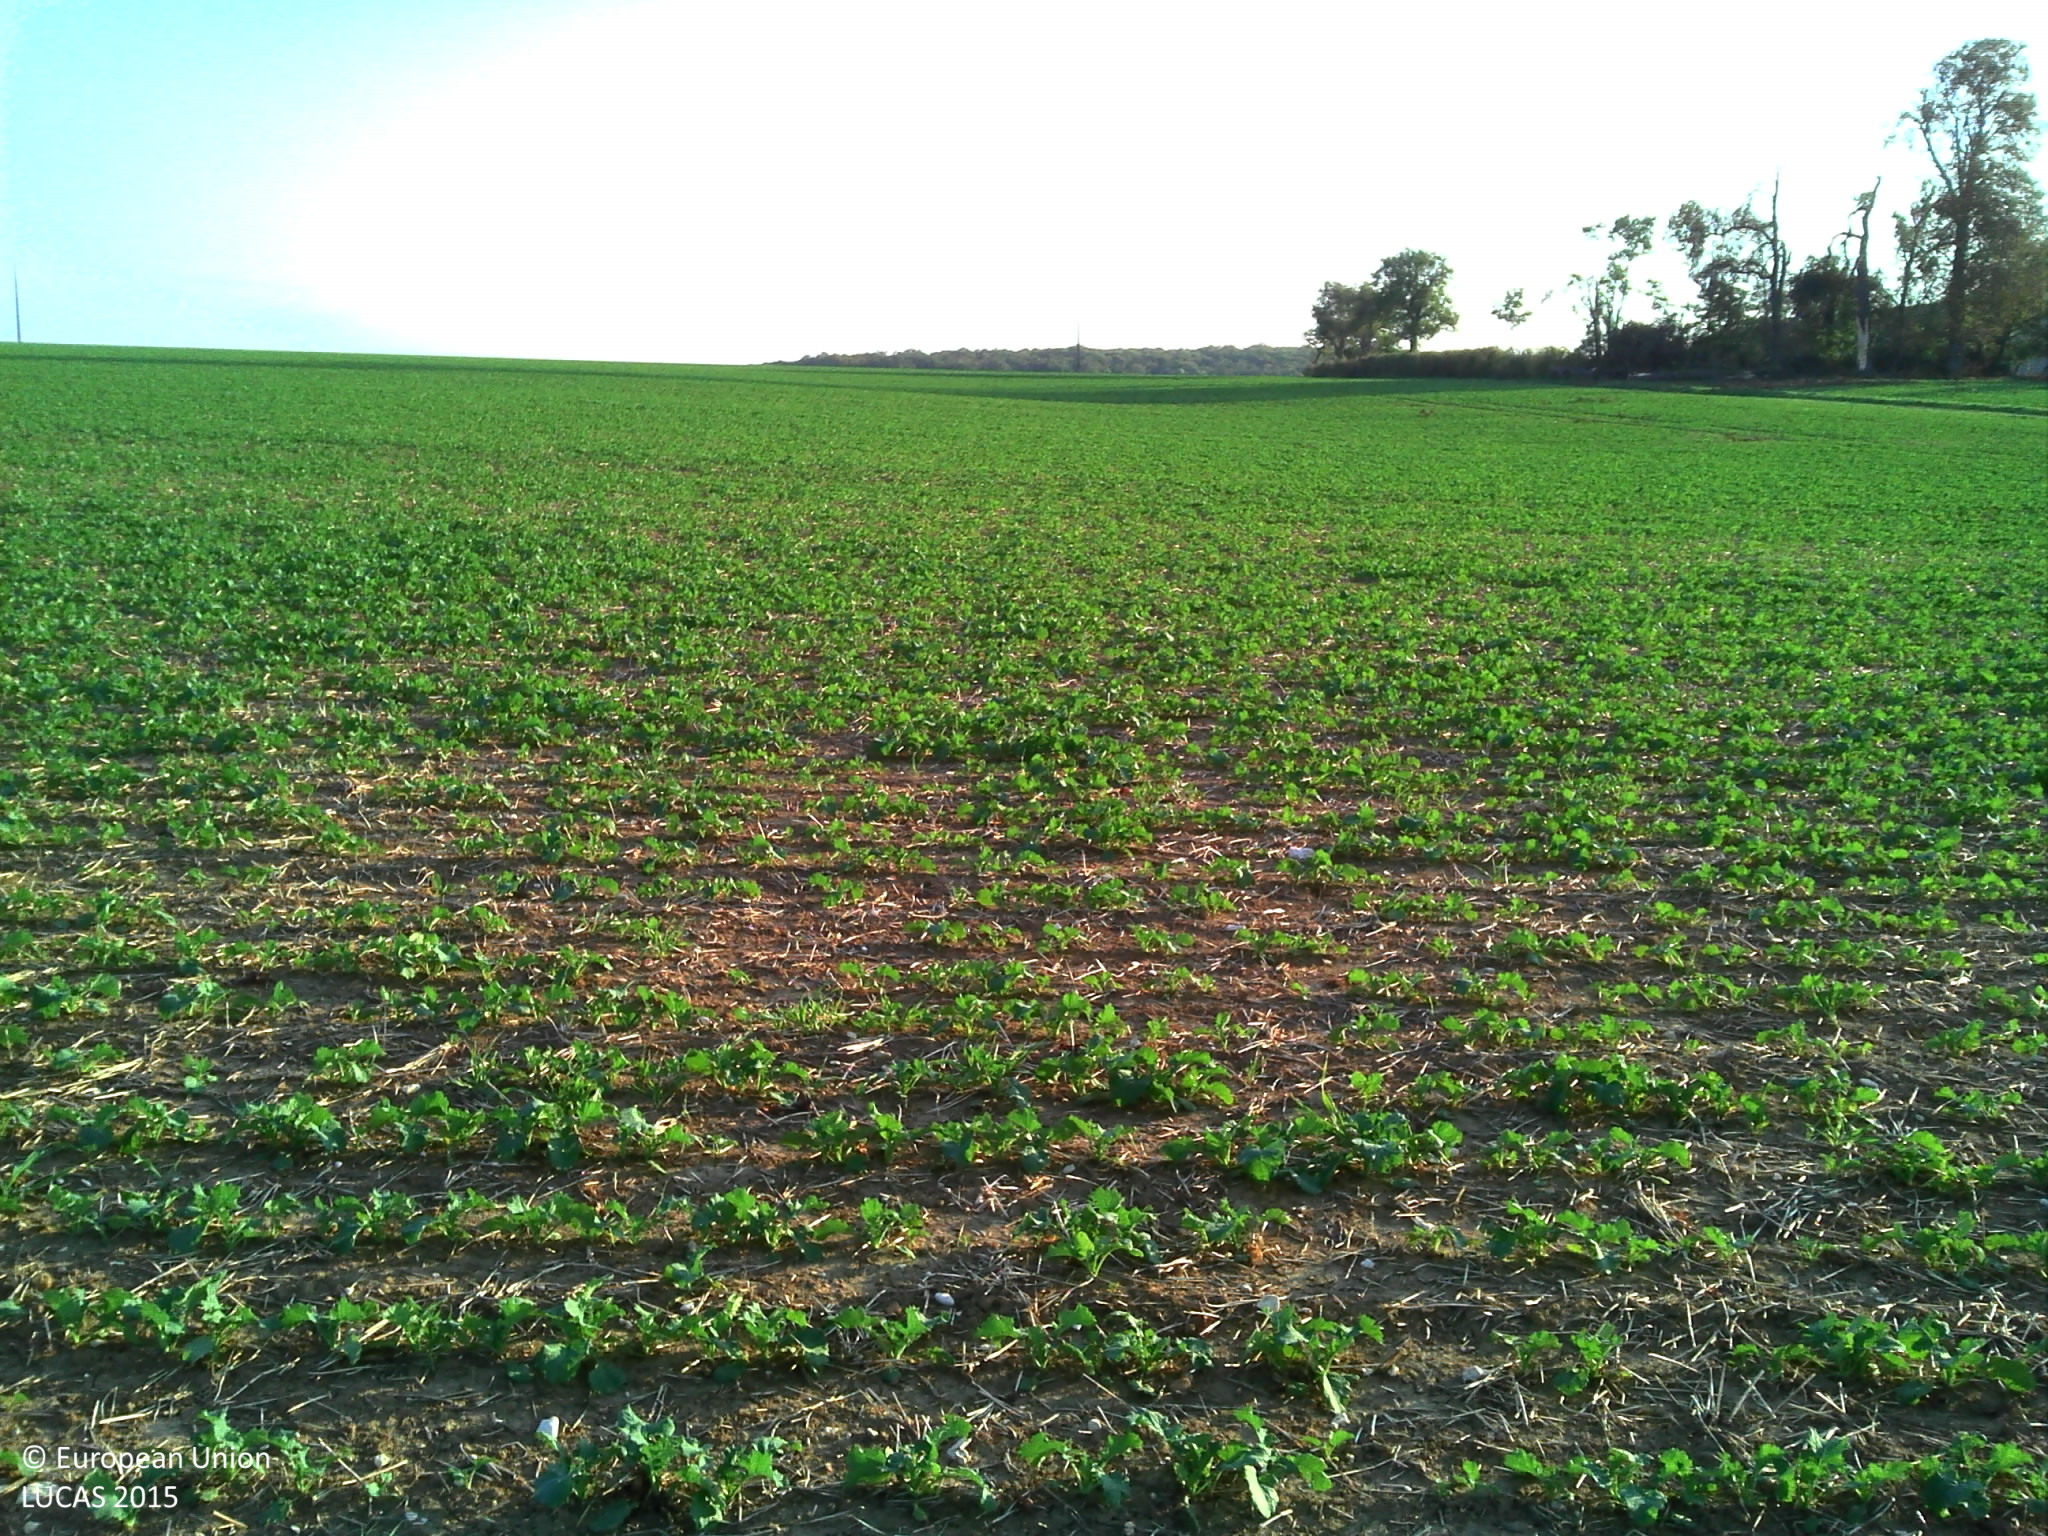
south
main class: Cropland
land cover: Rape and turnip rape
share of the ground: 25 - 50 %
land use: Agriculture (excluding fallow land and kitchen gardens)
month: October
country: FR
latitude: 48.1116
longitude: 4.2889
